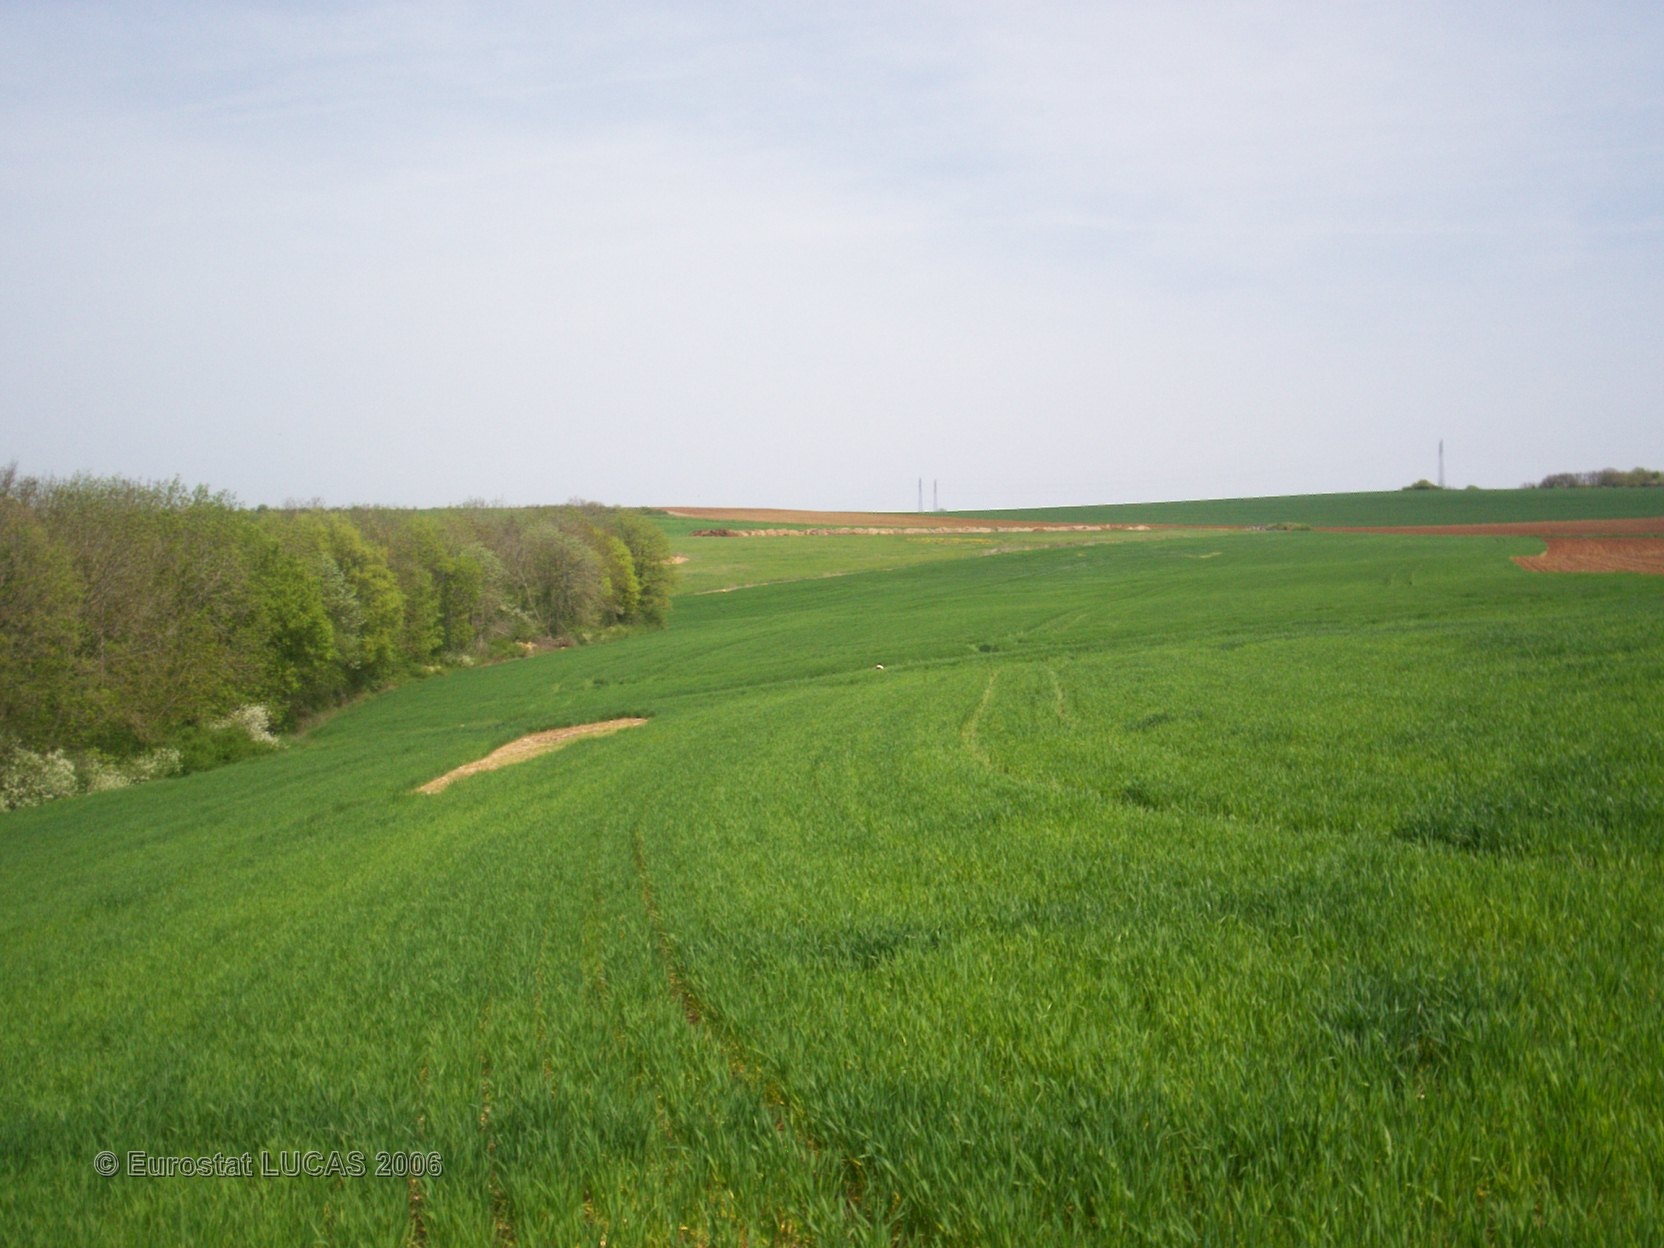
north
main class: Cropland
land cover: Common wheat
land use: Agriculture (excluding fallow land and kitchen gardens)
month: May
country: FR
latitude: 47.4805
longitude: 4.6515
